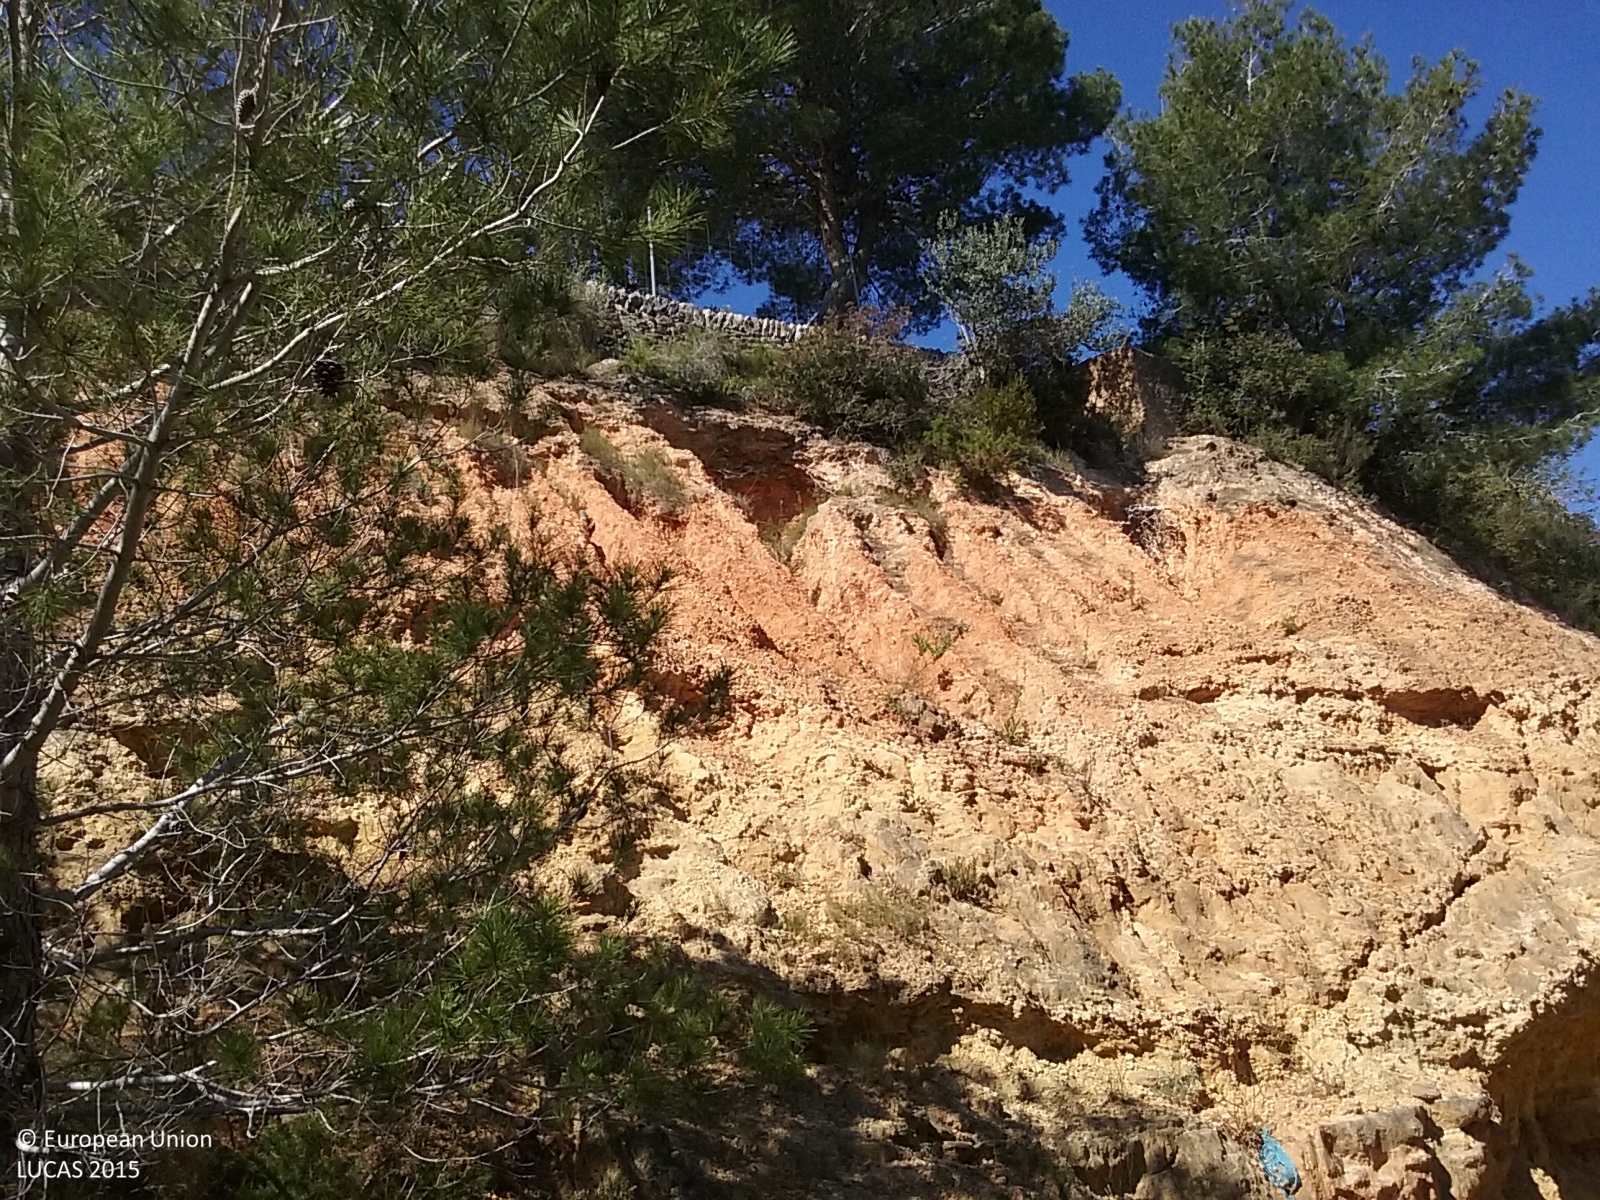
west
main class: Cropland
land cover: Permanent crops (only in case pi)
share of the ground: 25 - 50 %
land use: Agriculture (excluding fallow land and kitchen gardens)
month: April
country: ES
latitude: 40.7212
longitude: 0.5593
